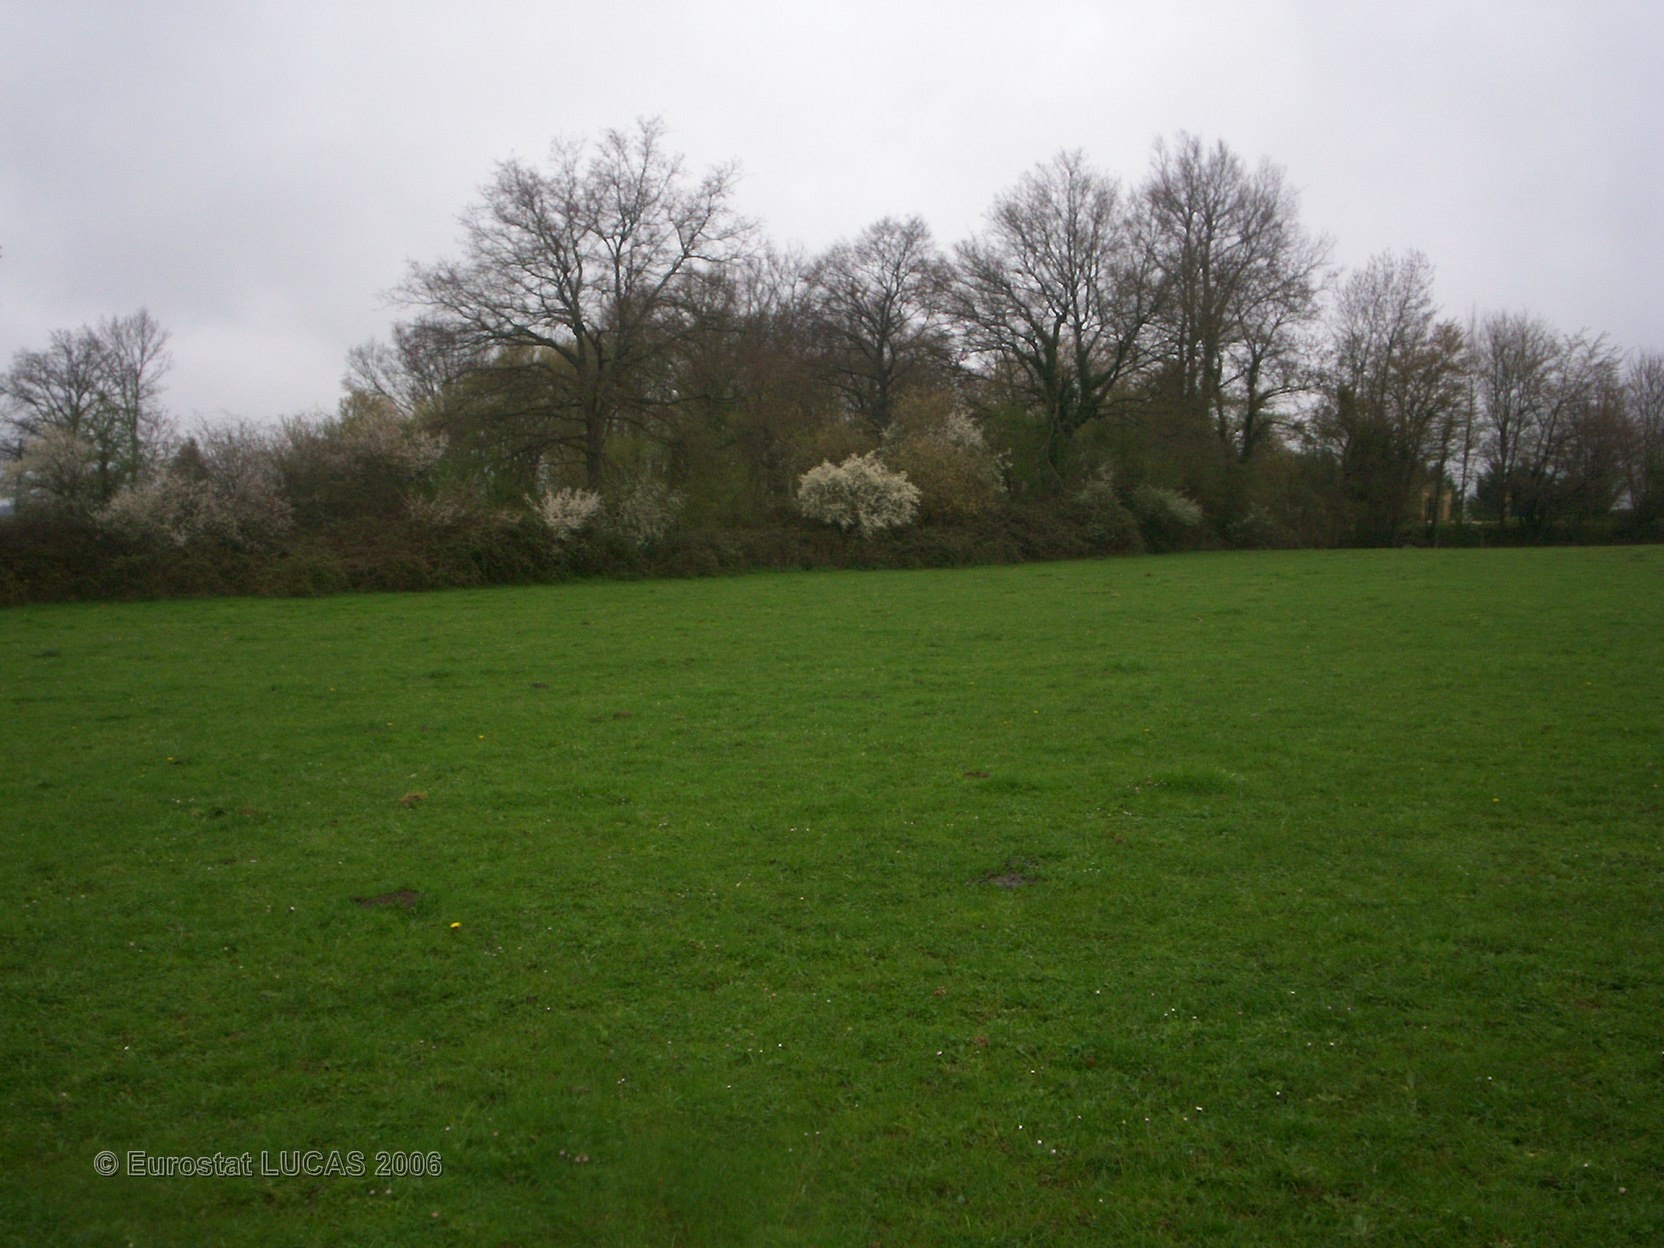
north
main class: Grassland
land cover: Grassland without tree/shrub cover
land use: Agriculture (excluding fallow land and kitchen gardens)
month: April
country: FR
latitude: 47.5309
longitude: 2.9940
